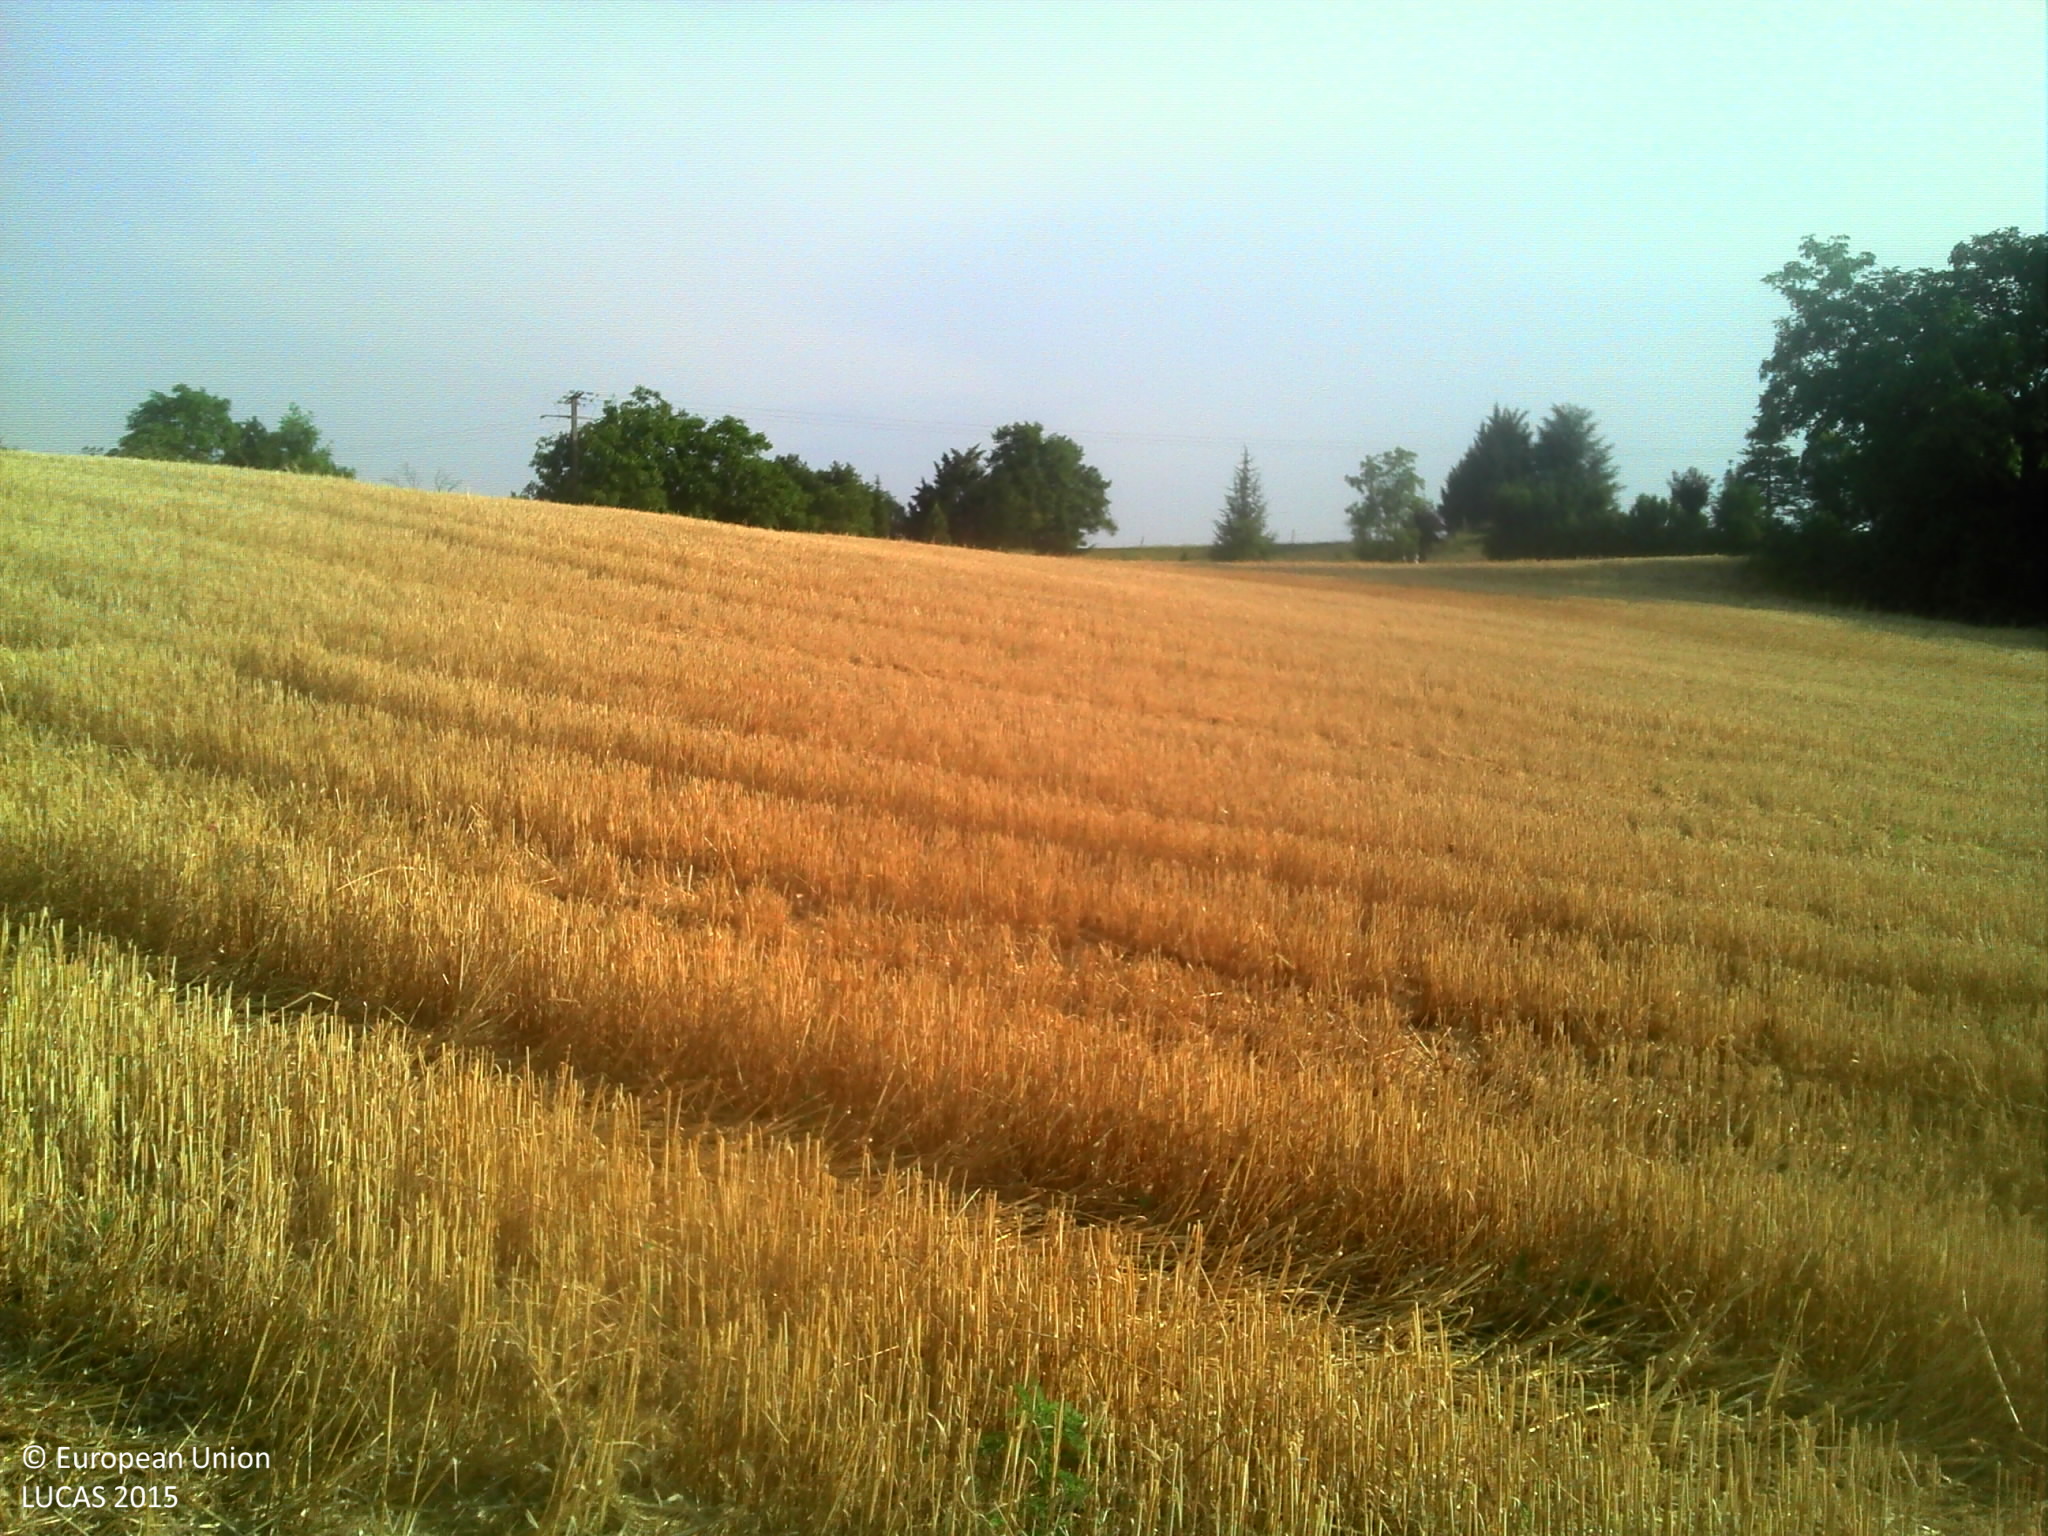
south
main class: Grassland
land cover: Grassland with sparse tree/shrub cover
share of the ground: > 75 %
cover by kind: herbaceous plants 95 %, coniferous forest trees 5 %
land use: Residential
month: July
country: FR
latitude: 45.6476
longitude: 5.1924
